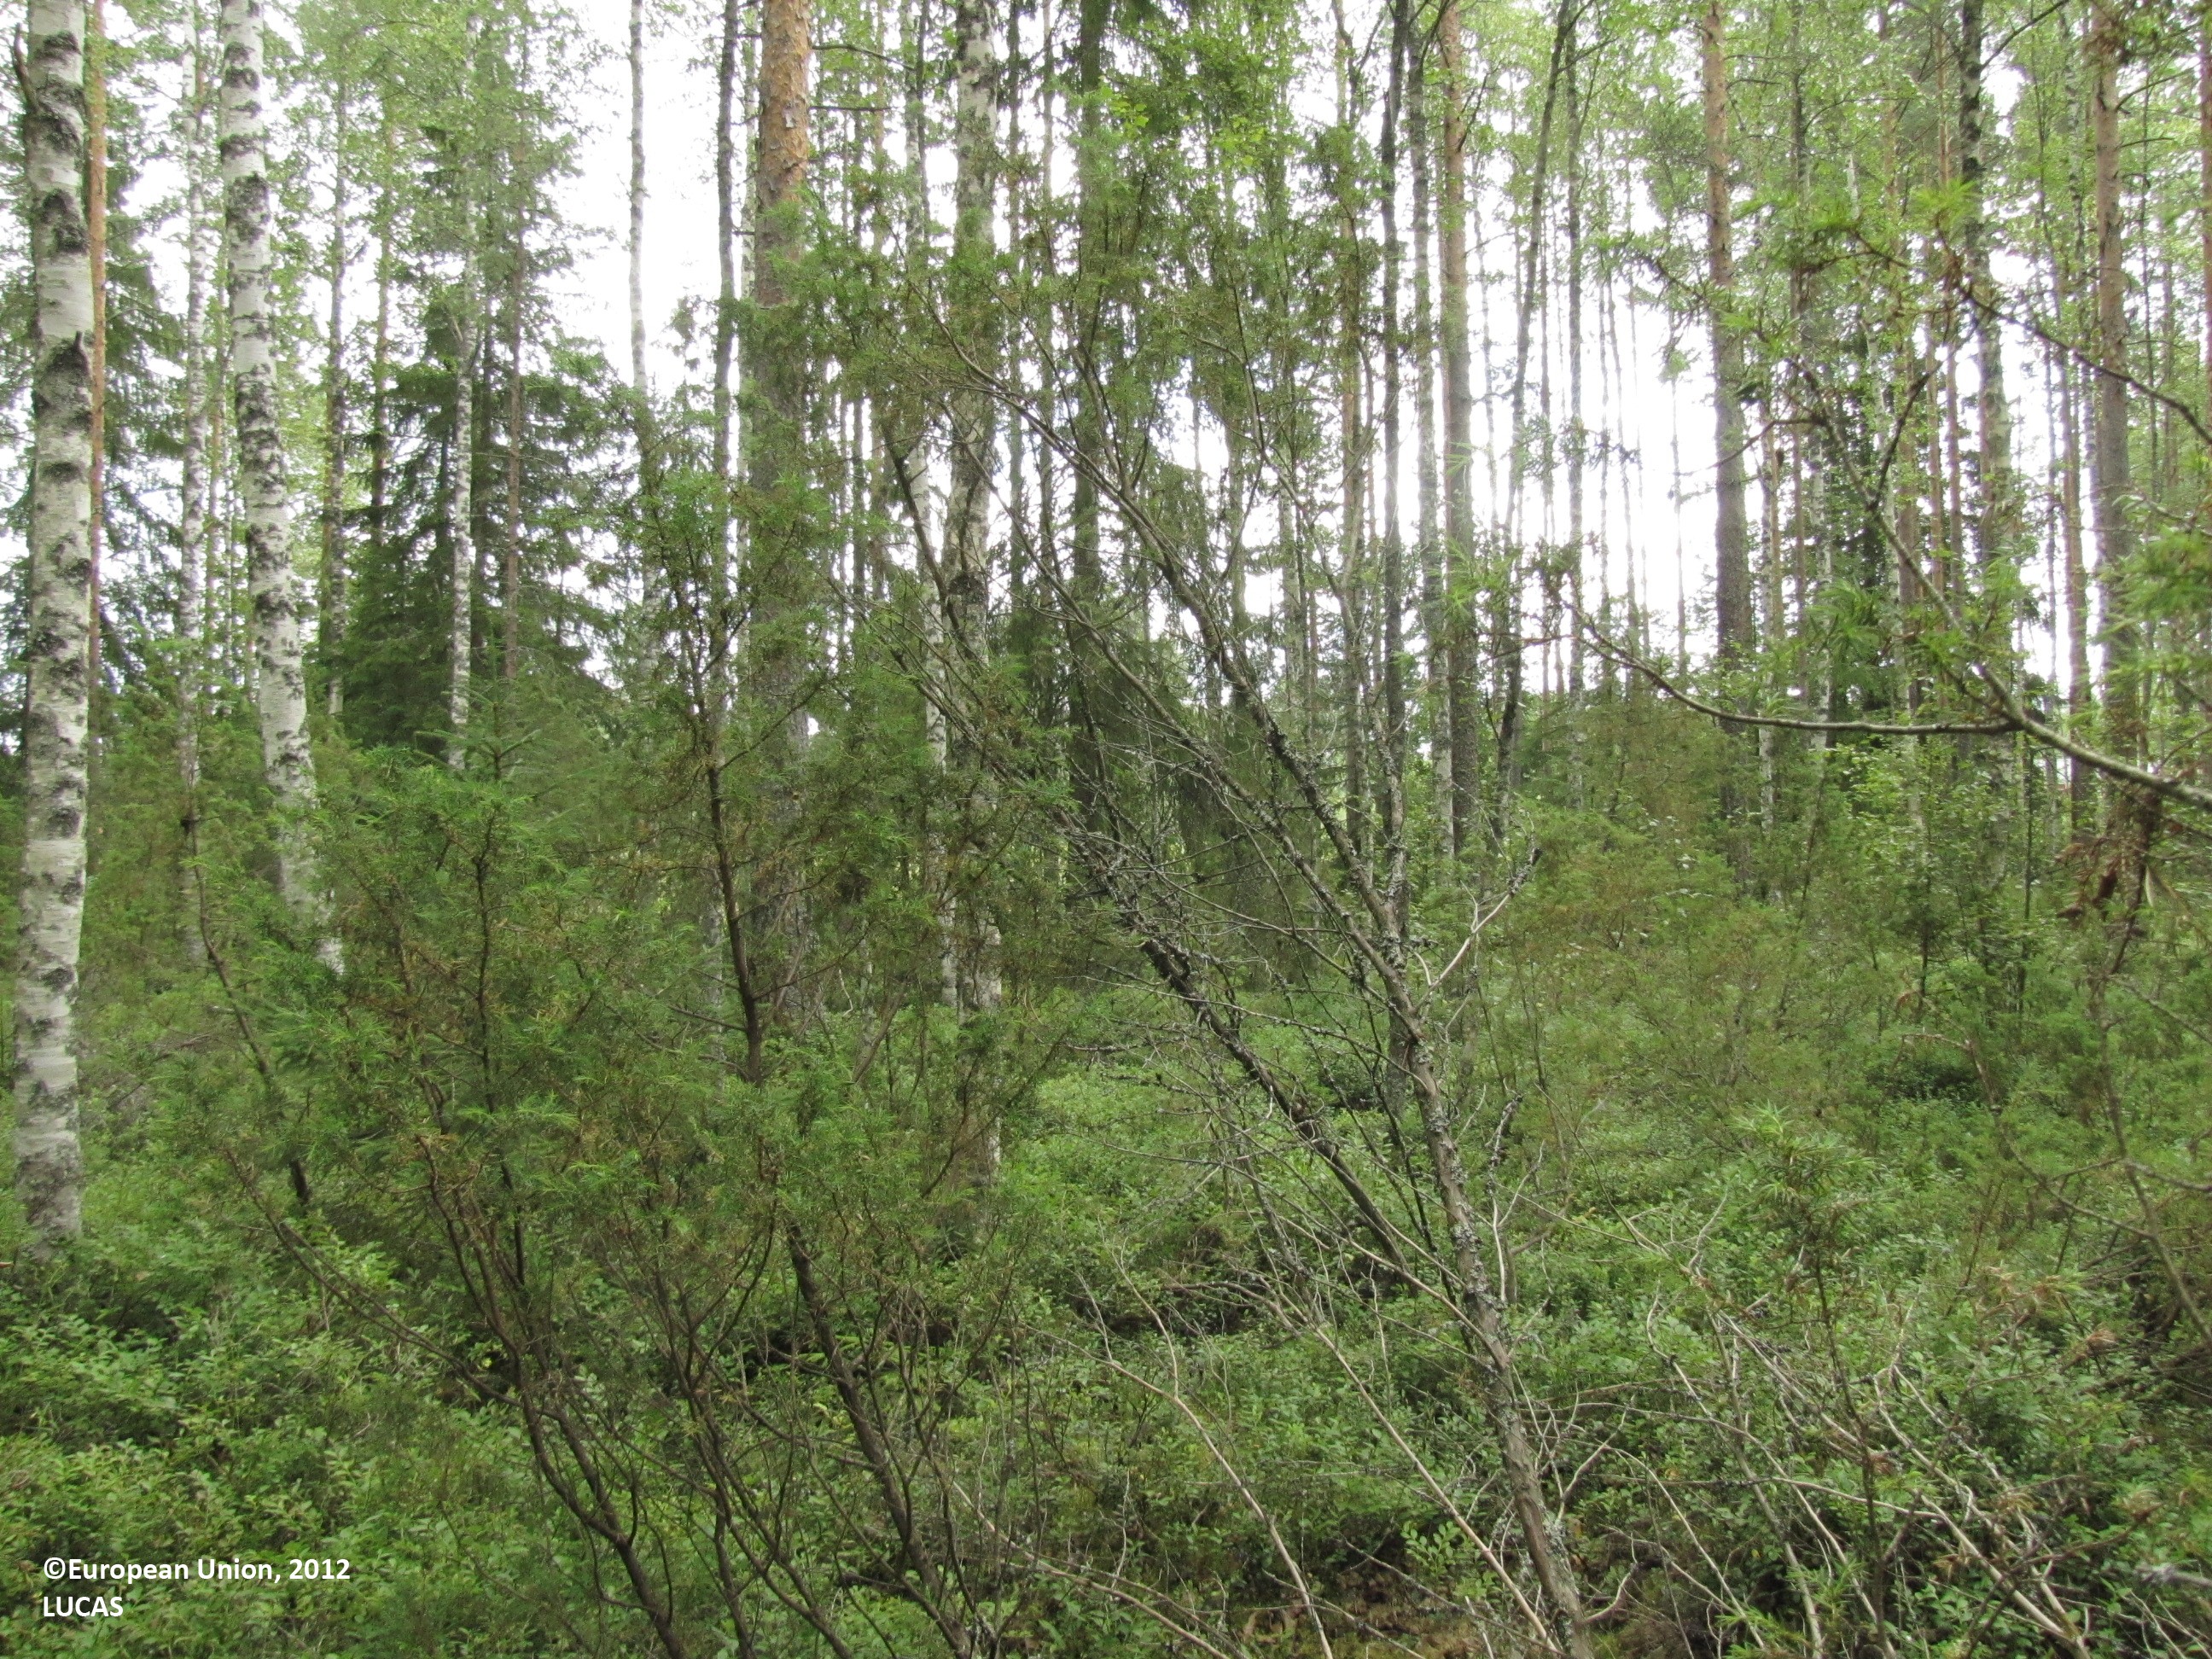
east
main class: Woodland
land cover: Other mixed woodland
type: boreal forest
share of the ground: > 75 %
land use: Forestry
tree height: > 5 m
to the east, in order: Other mixed woodland; Ditches and canals; Grassland without tree/shrub cover; Ditches and canals; Grassland without tree/shrub cover; Ditches and canals; Barley; Ditches and canals; Abandoned hedges; Grassland without tree/shrub cover; Abandoned hedges; Ditches and canals; Abandoned hedges; Broadleaved woodland; Grass margins; Ditches and canals; Paved roads, cycling and walking lanes; Grassland without tree/shrub cover; Electric lines; Grassland without tree/shrub cover
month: July
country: FI
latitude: 62.6363
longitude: 22.9517
